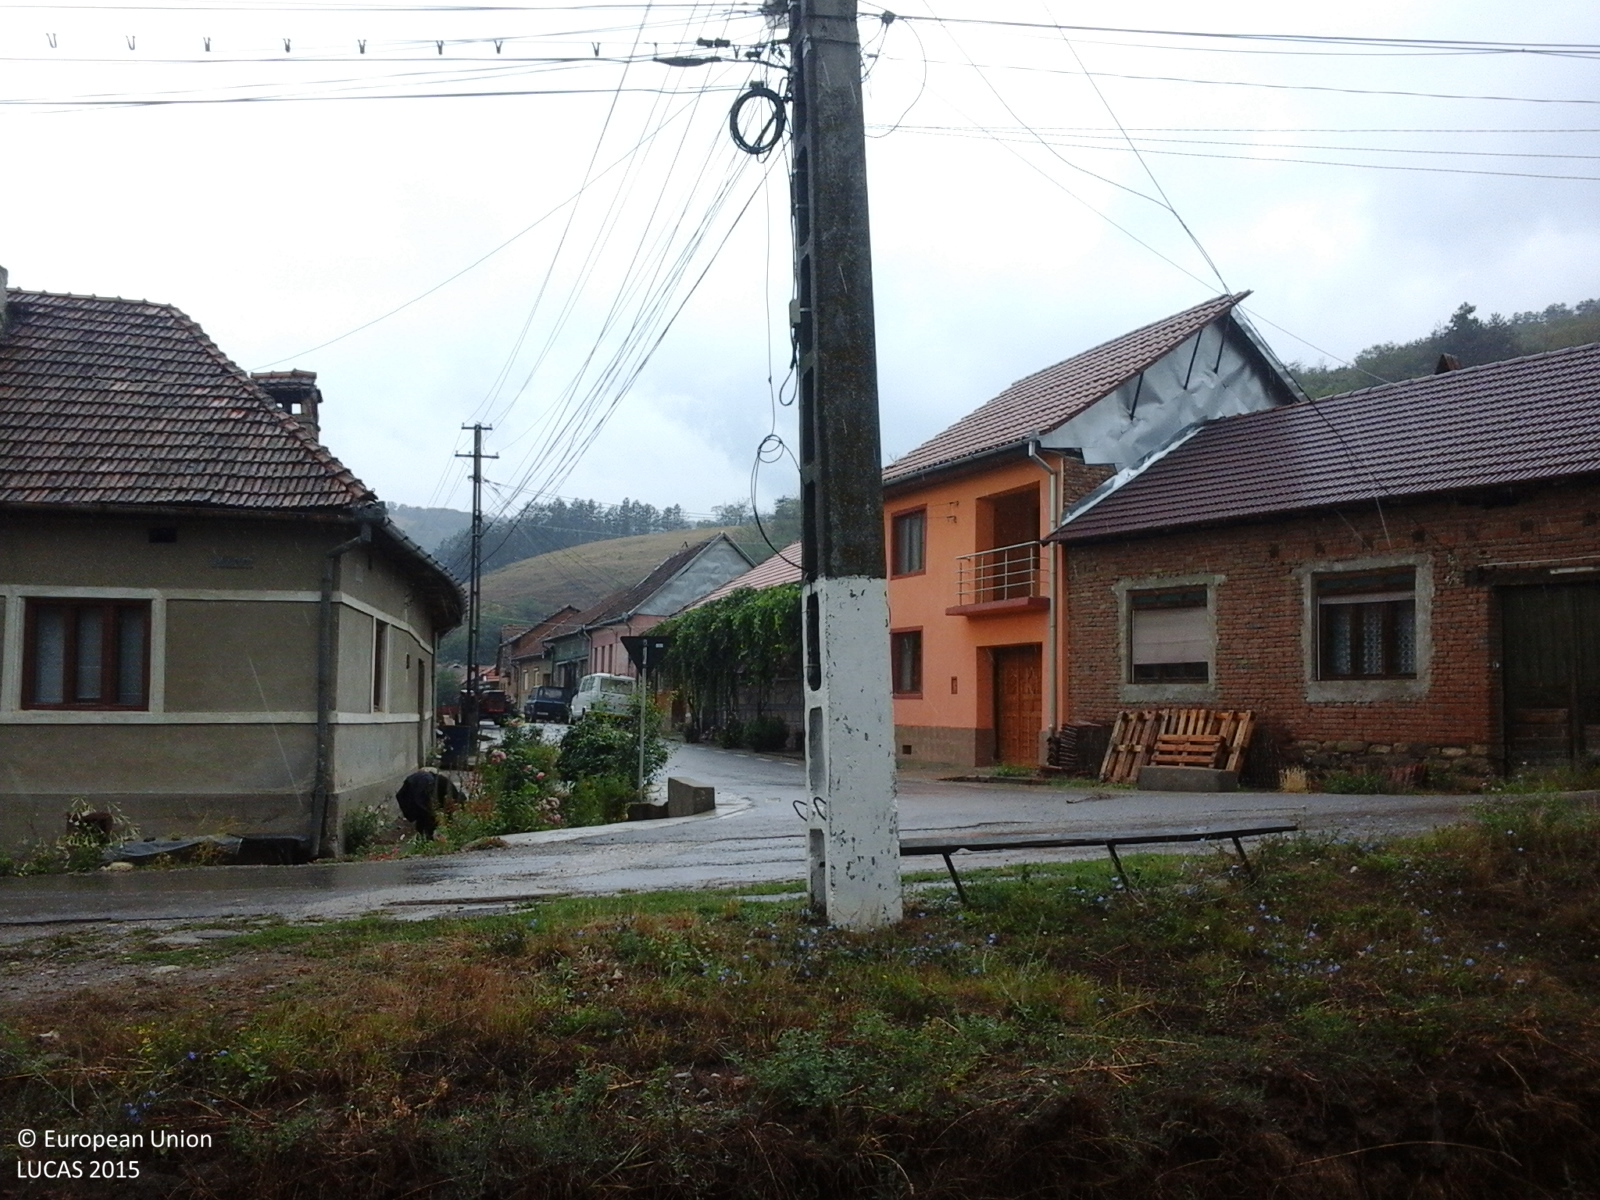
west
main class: Grassland
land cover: Grassland without tree/shrub cover
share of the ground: > 75 %
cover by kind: herbaceous plants 100 %
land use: Residential
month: August
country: RO
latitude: 45.0414
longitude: 22.2643
